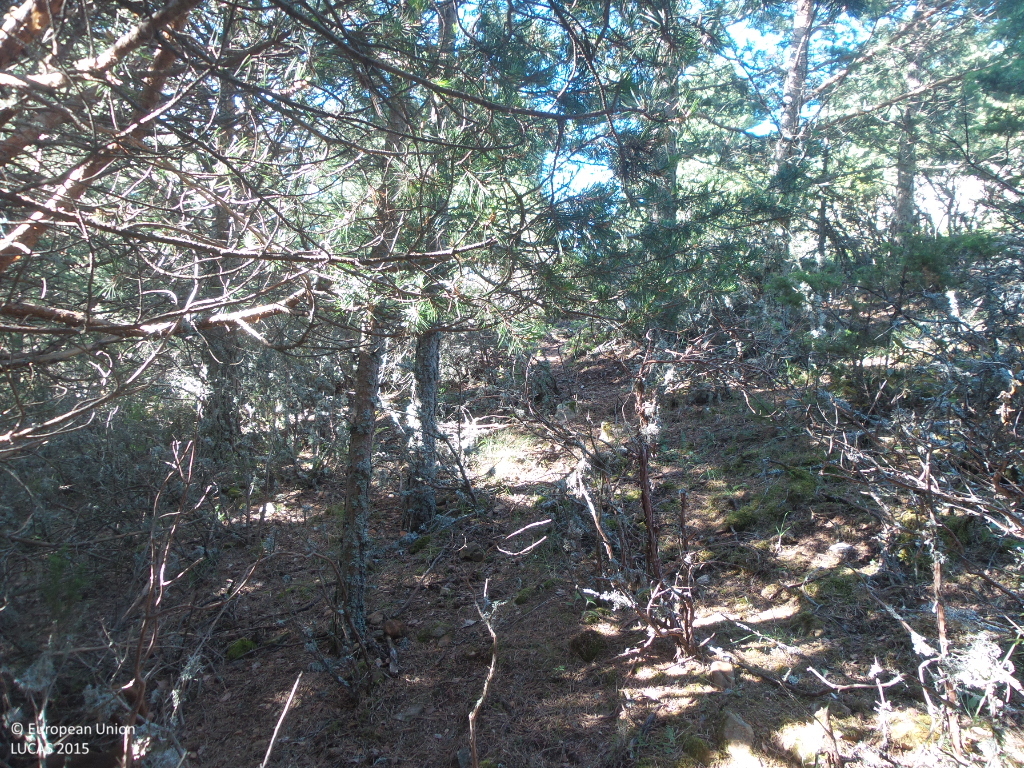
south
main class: Woodland
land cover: Pine dominated coniferous woodland
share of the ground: > 75 %
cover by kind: coniferous forest trees 80 %, shrubs 20 %
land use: Semi-natural and natural areas not in use
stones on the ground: < 10 %
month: June
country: ES
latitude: 41.1578
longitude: -3.1119
